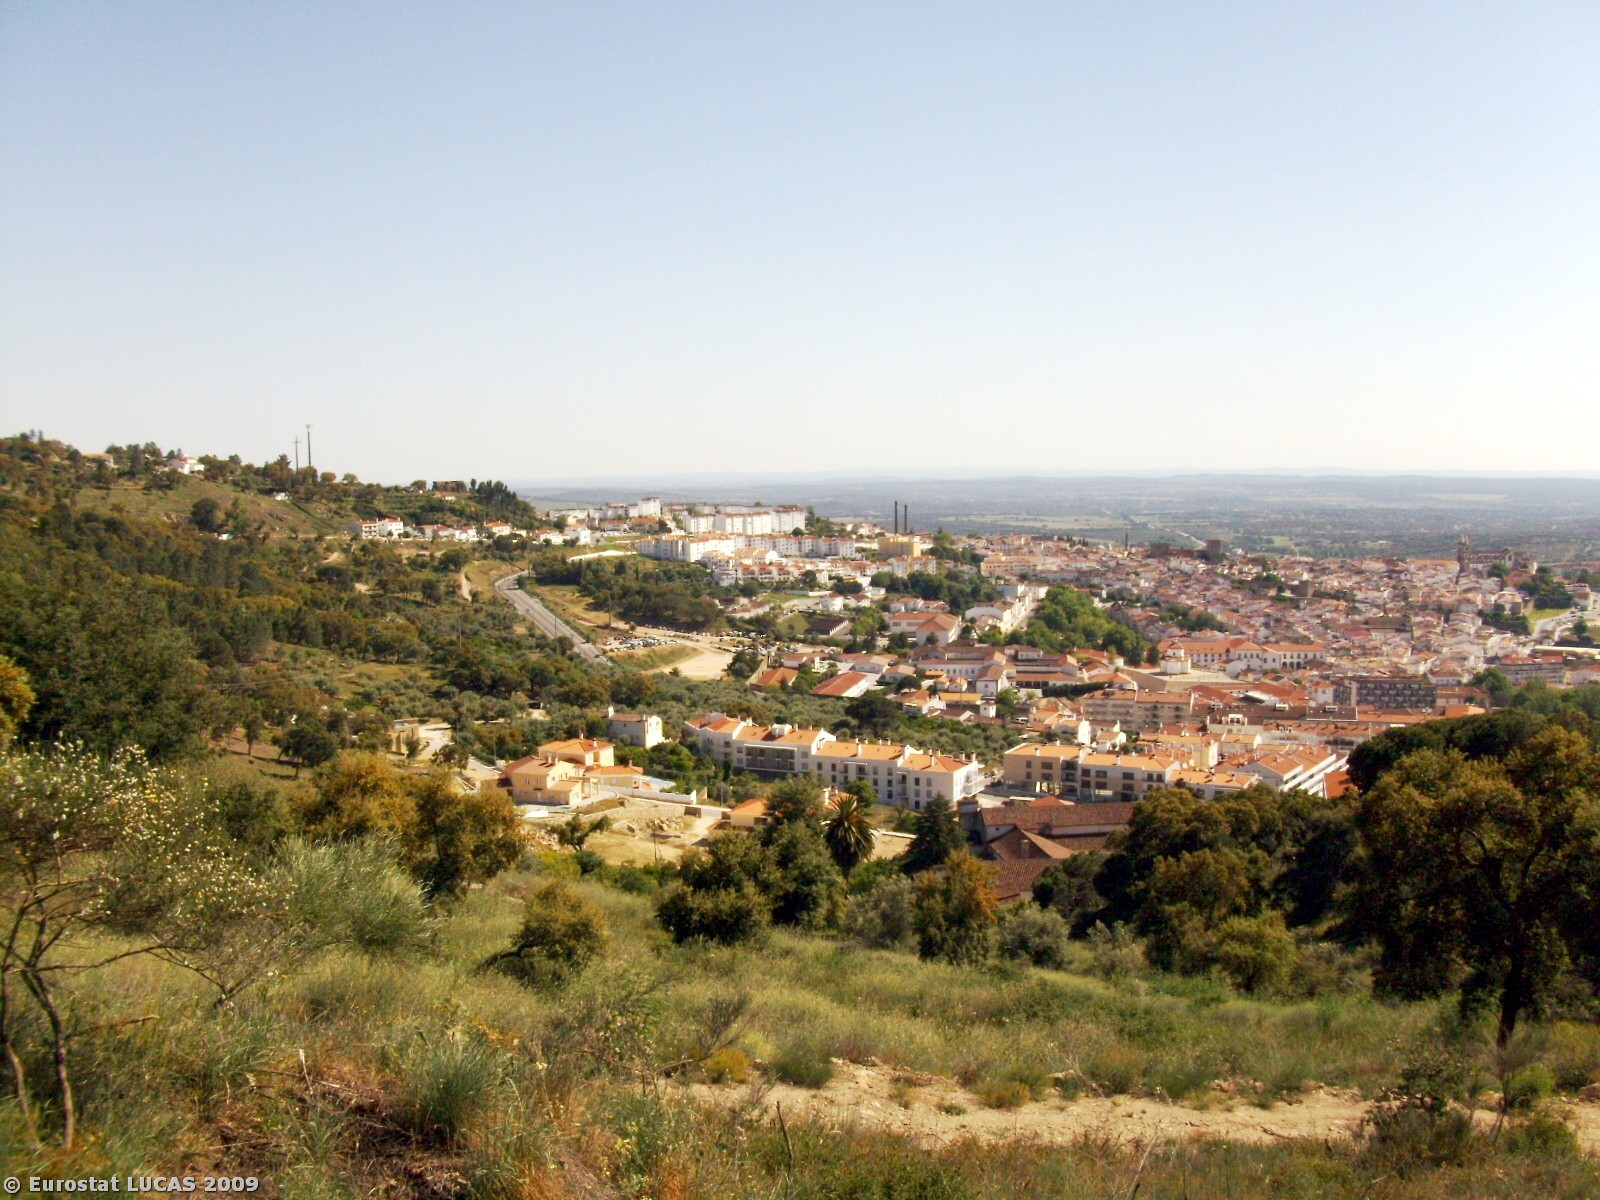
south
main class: Grassland
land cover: Grassland with sparse tree/shrub cover
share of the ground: 50 - 75 %
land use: Forestry
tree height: > 5 m
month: May
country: PT
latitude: 39.3036
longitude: -7.4245
